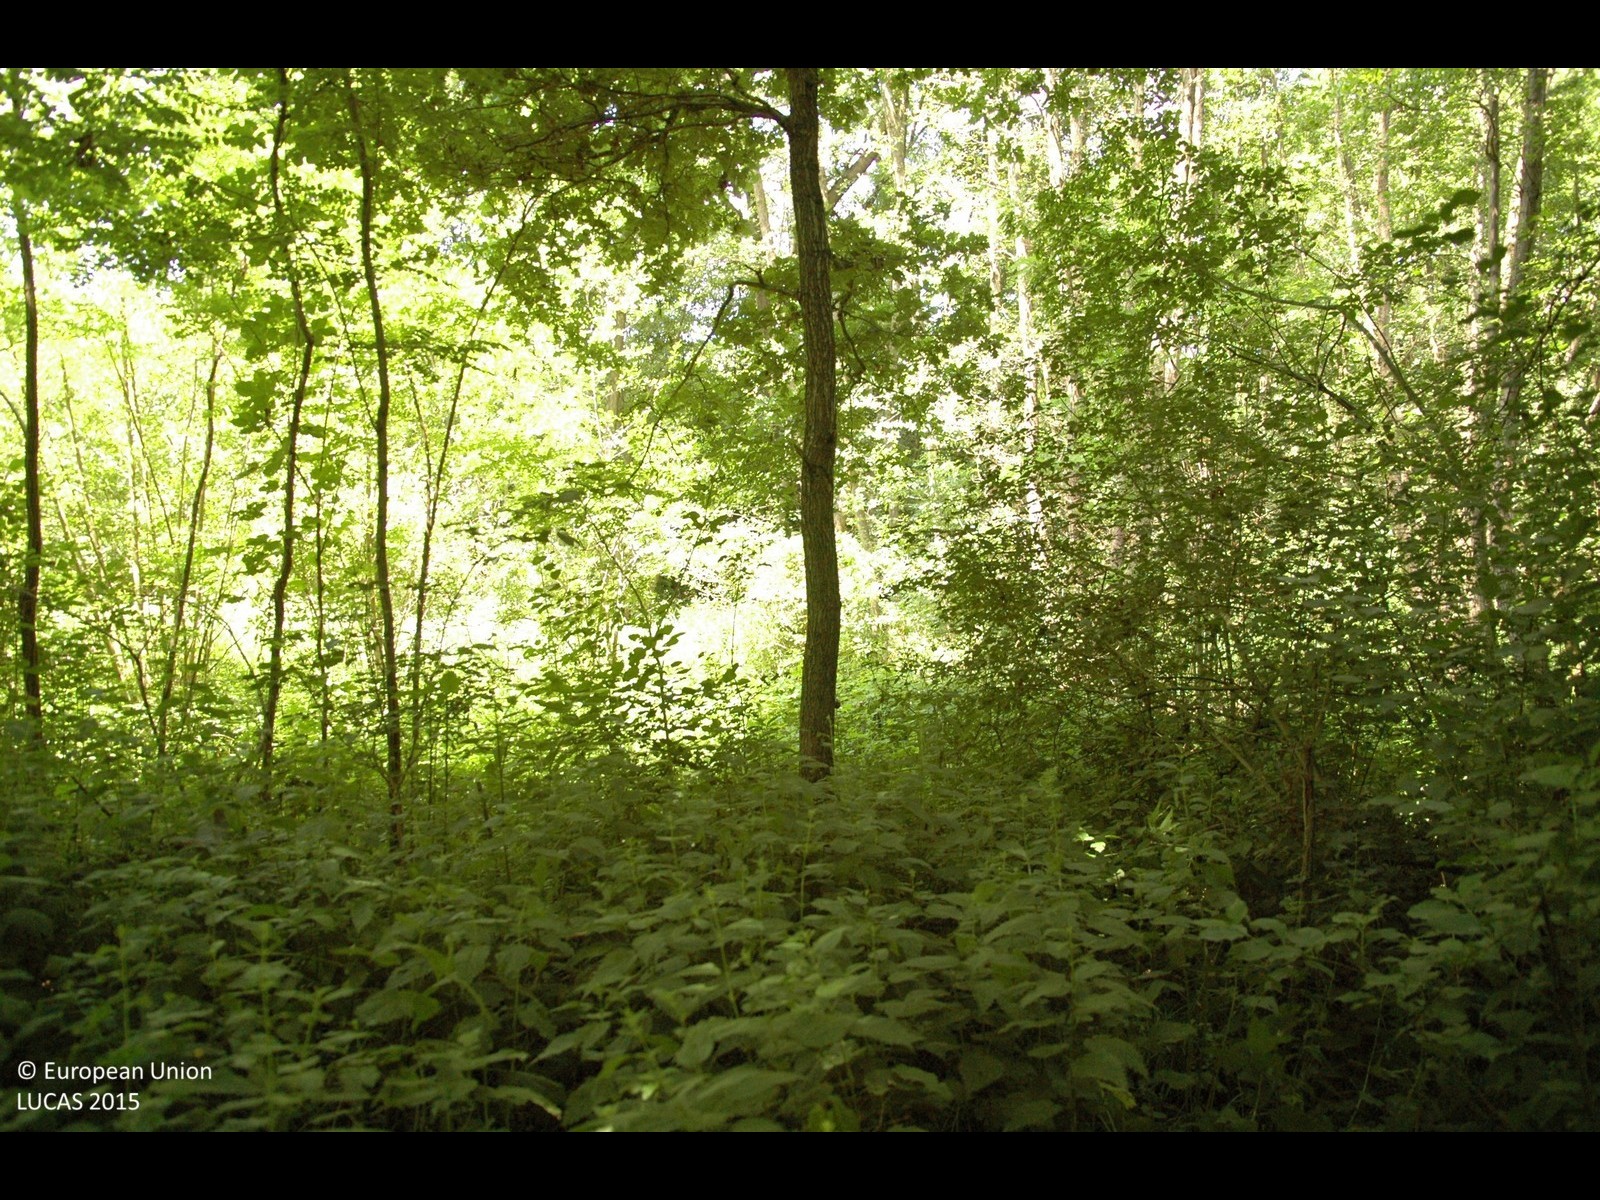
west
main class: Woodland
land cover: Broadleaved woodland
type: mesophytic deciduous forest
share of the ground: > 75 %
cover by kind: broadleaved forest trees 100 %
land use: Forestry
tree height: > 5 m
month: June
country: HR
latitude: 46.4136
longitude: 16.6754
